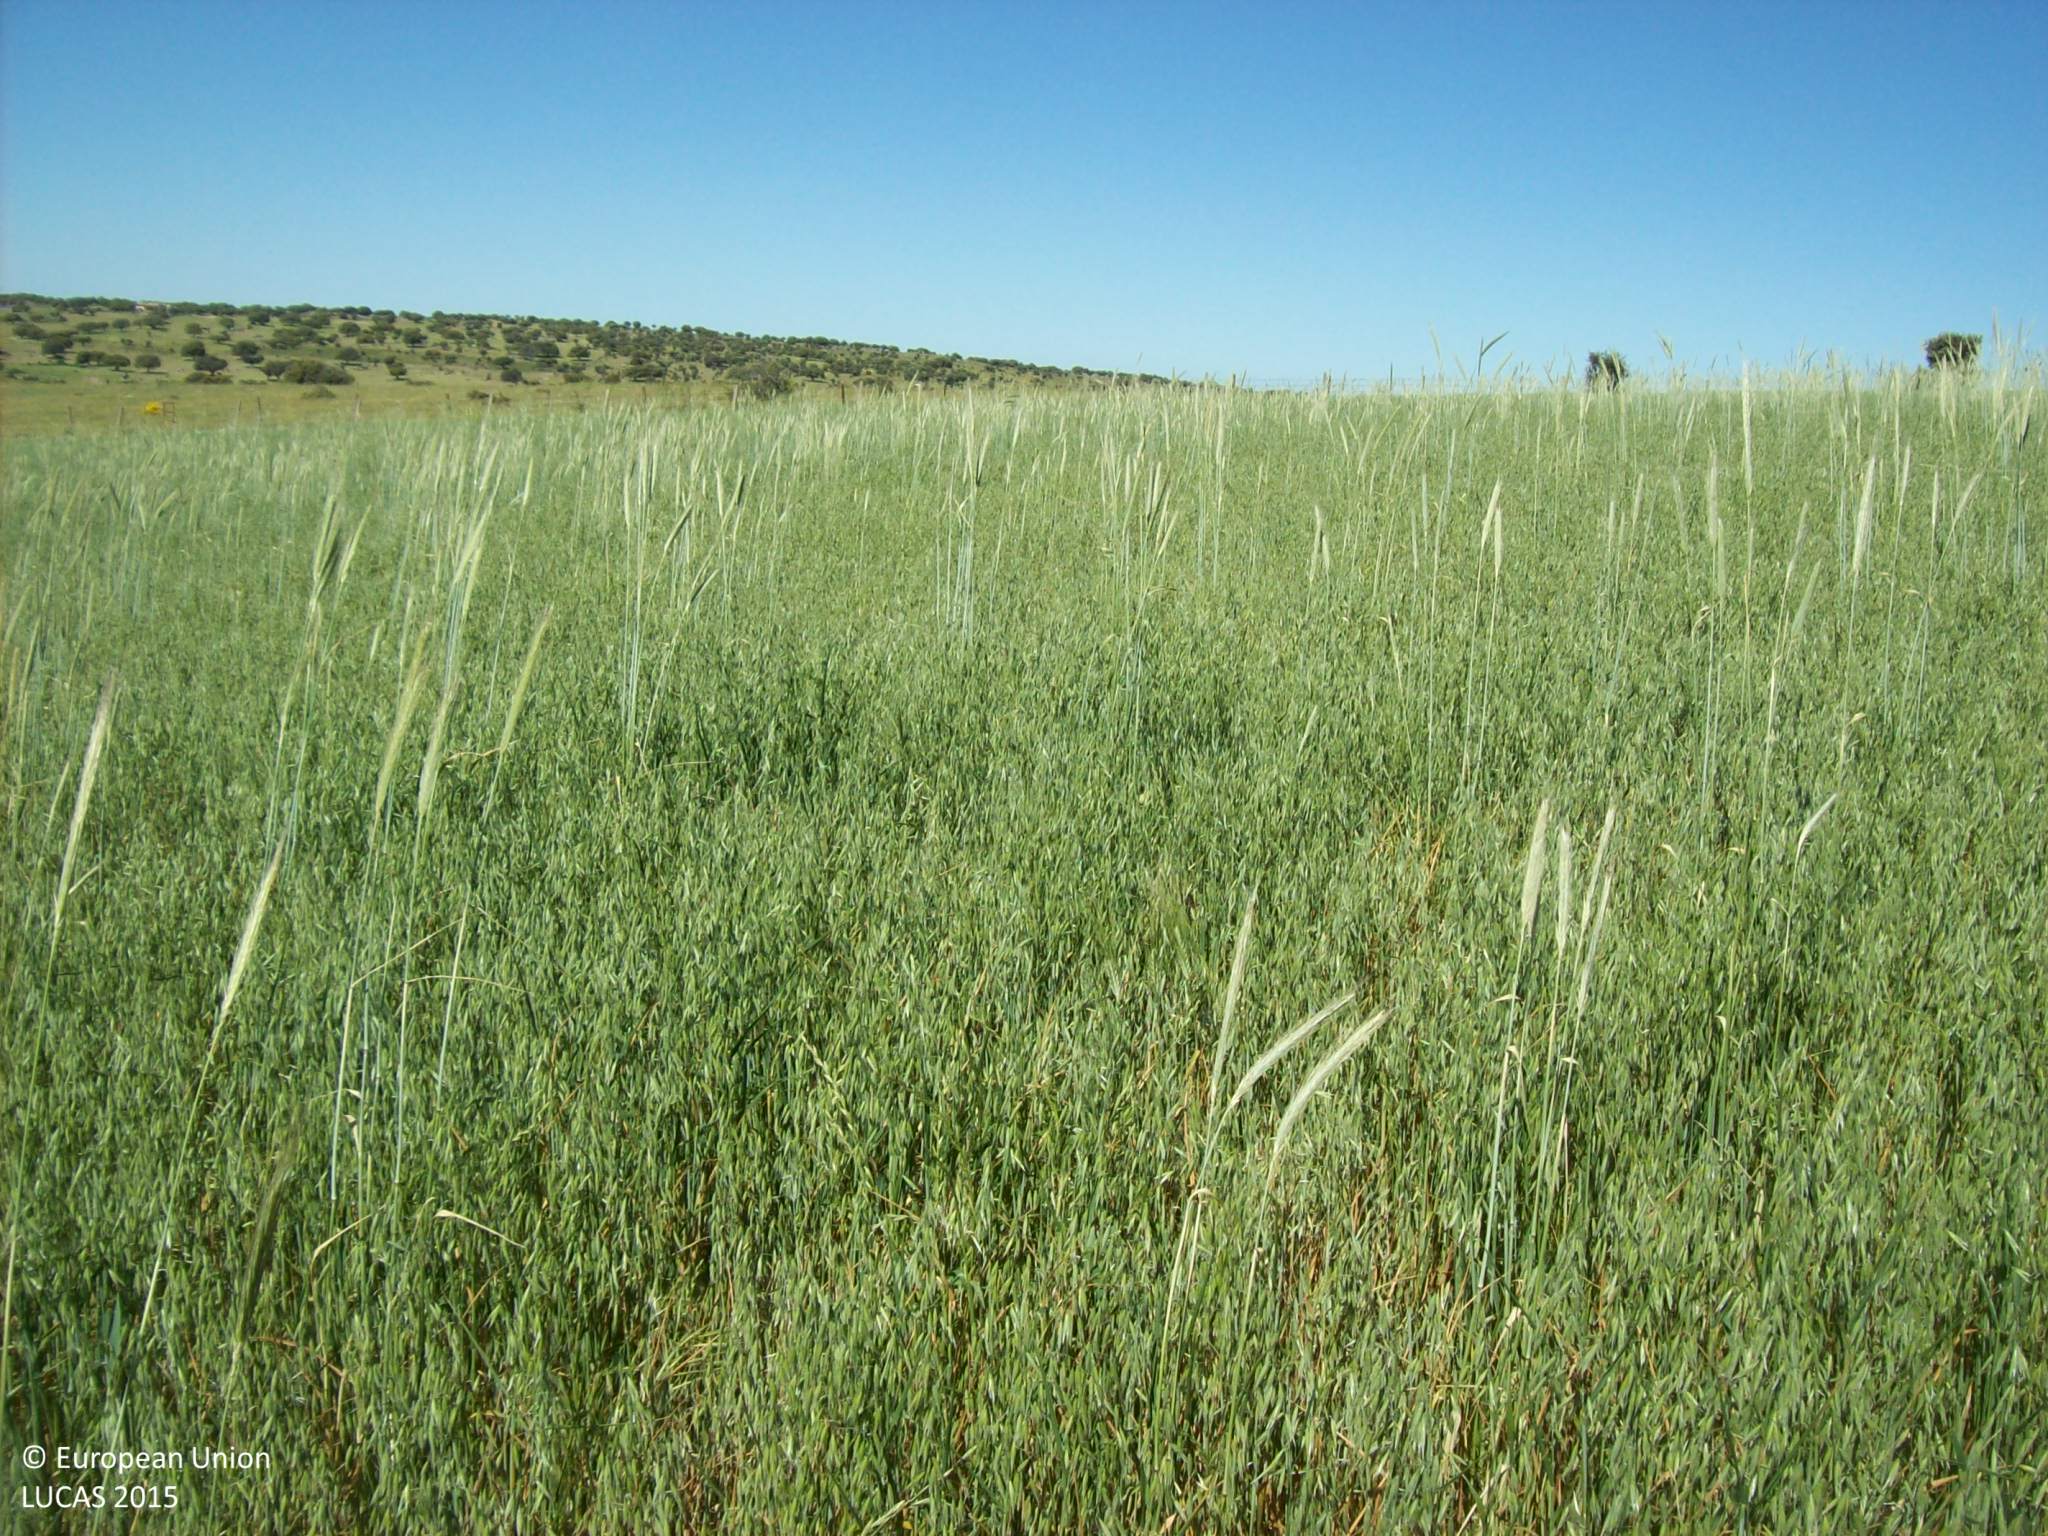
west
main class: Cropland
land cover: Mixed cereals for fodder
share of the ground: > 75 %
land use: Agriculture (excluding fallow land and kitchen gardens)
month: May
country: ES
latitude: 40.7237
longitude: -5.1111
